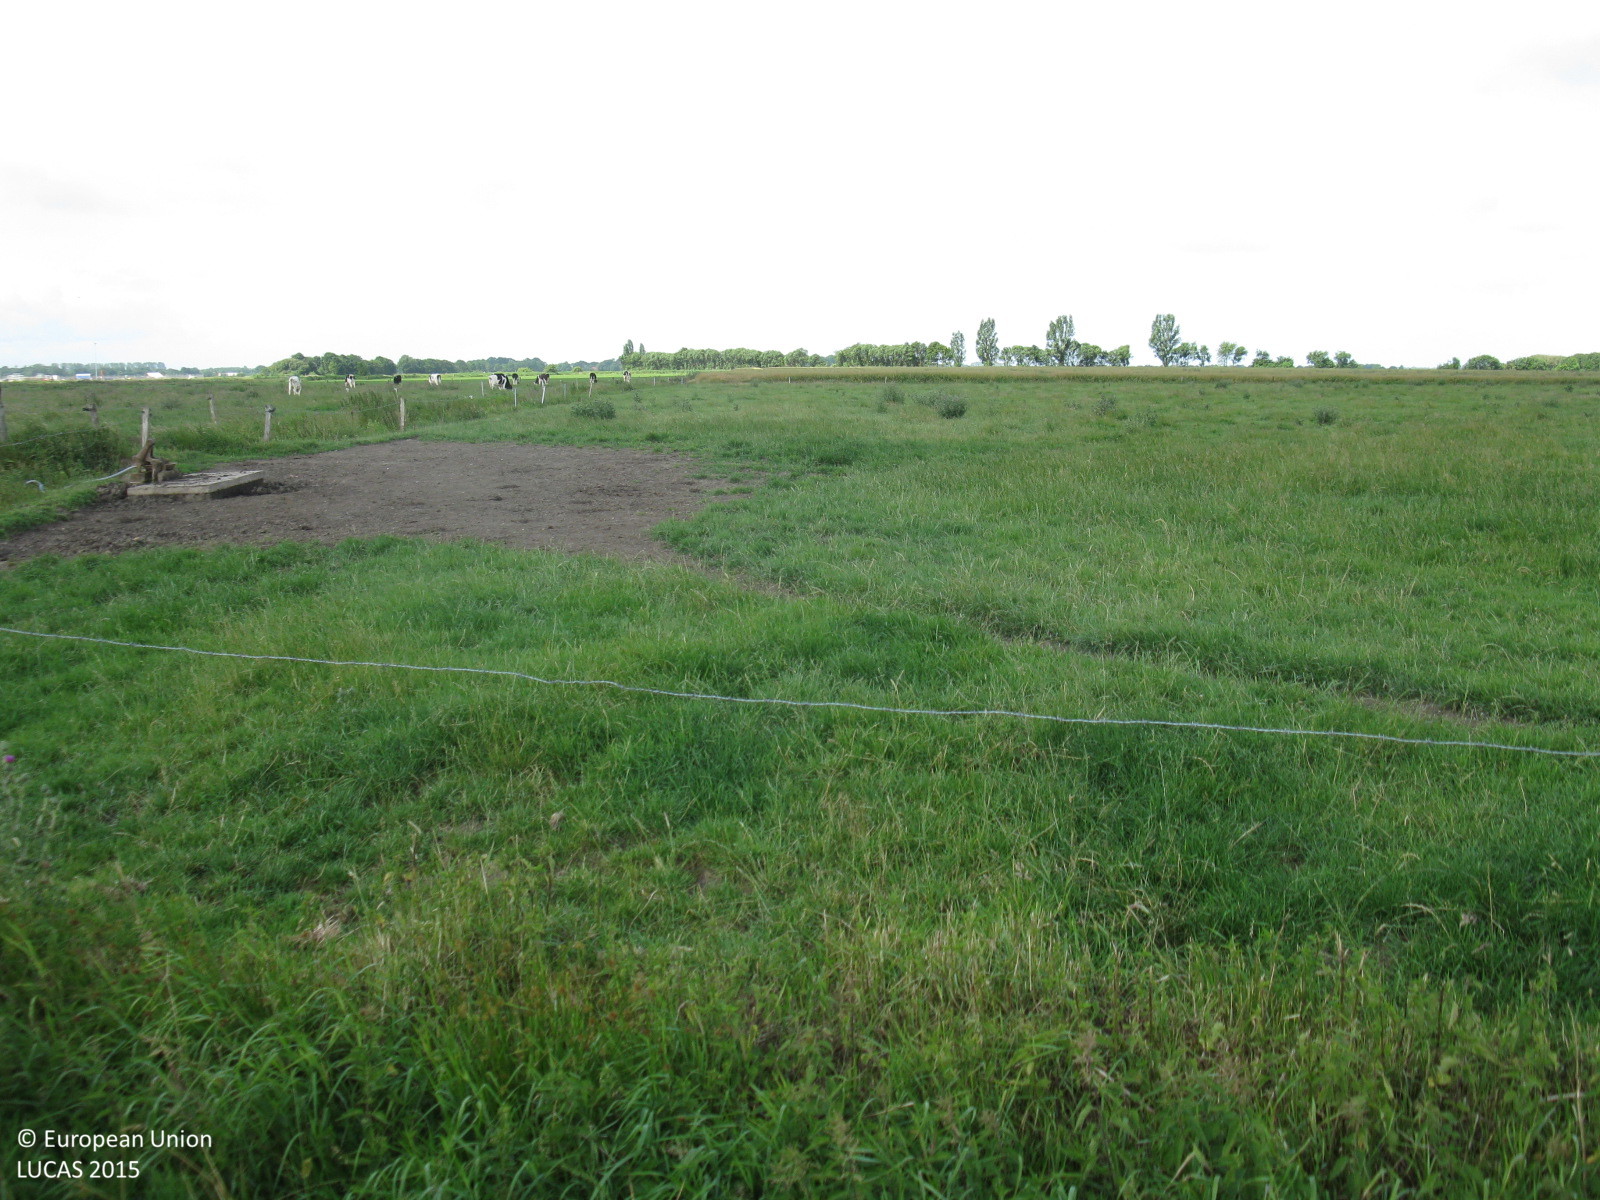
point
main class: Grassland
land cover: Grassland without tree/shrub cover
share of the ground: > 75 %
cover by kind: herbaceous plants 100 %
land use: Agriculture (excluding fallow land and kitchen gardens)
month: July
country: DE
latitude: 53.4743
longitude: 7.9366
